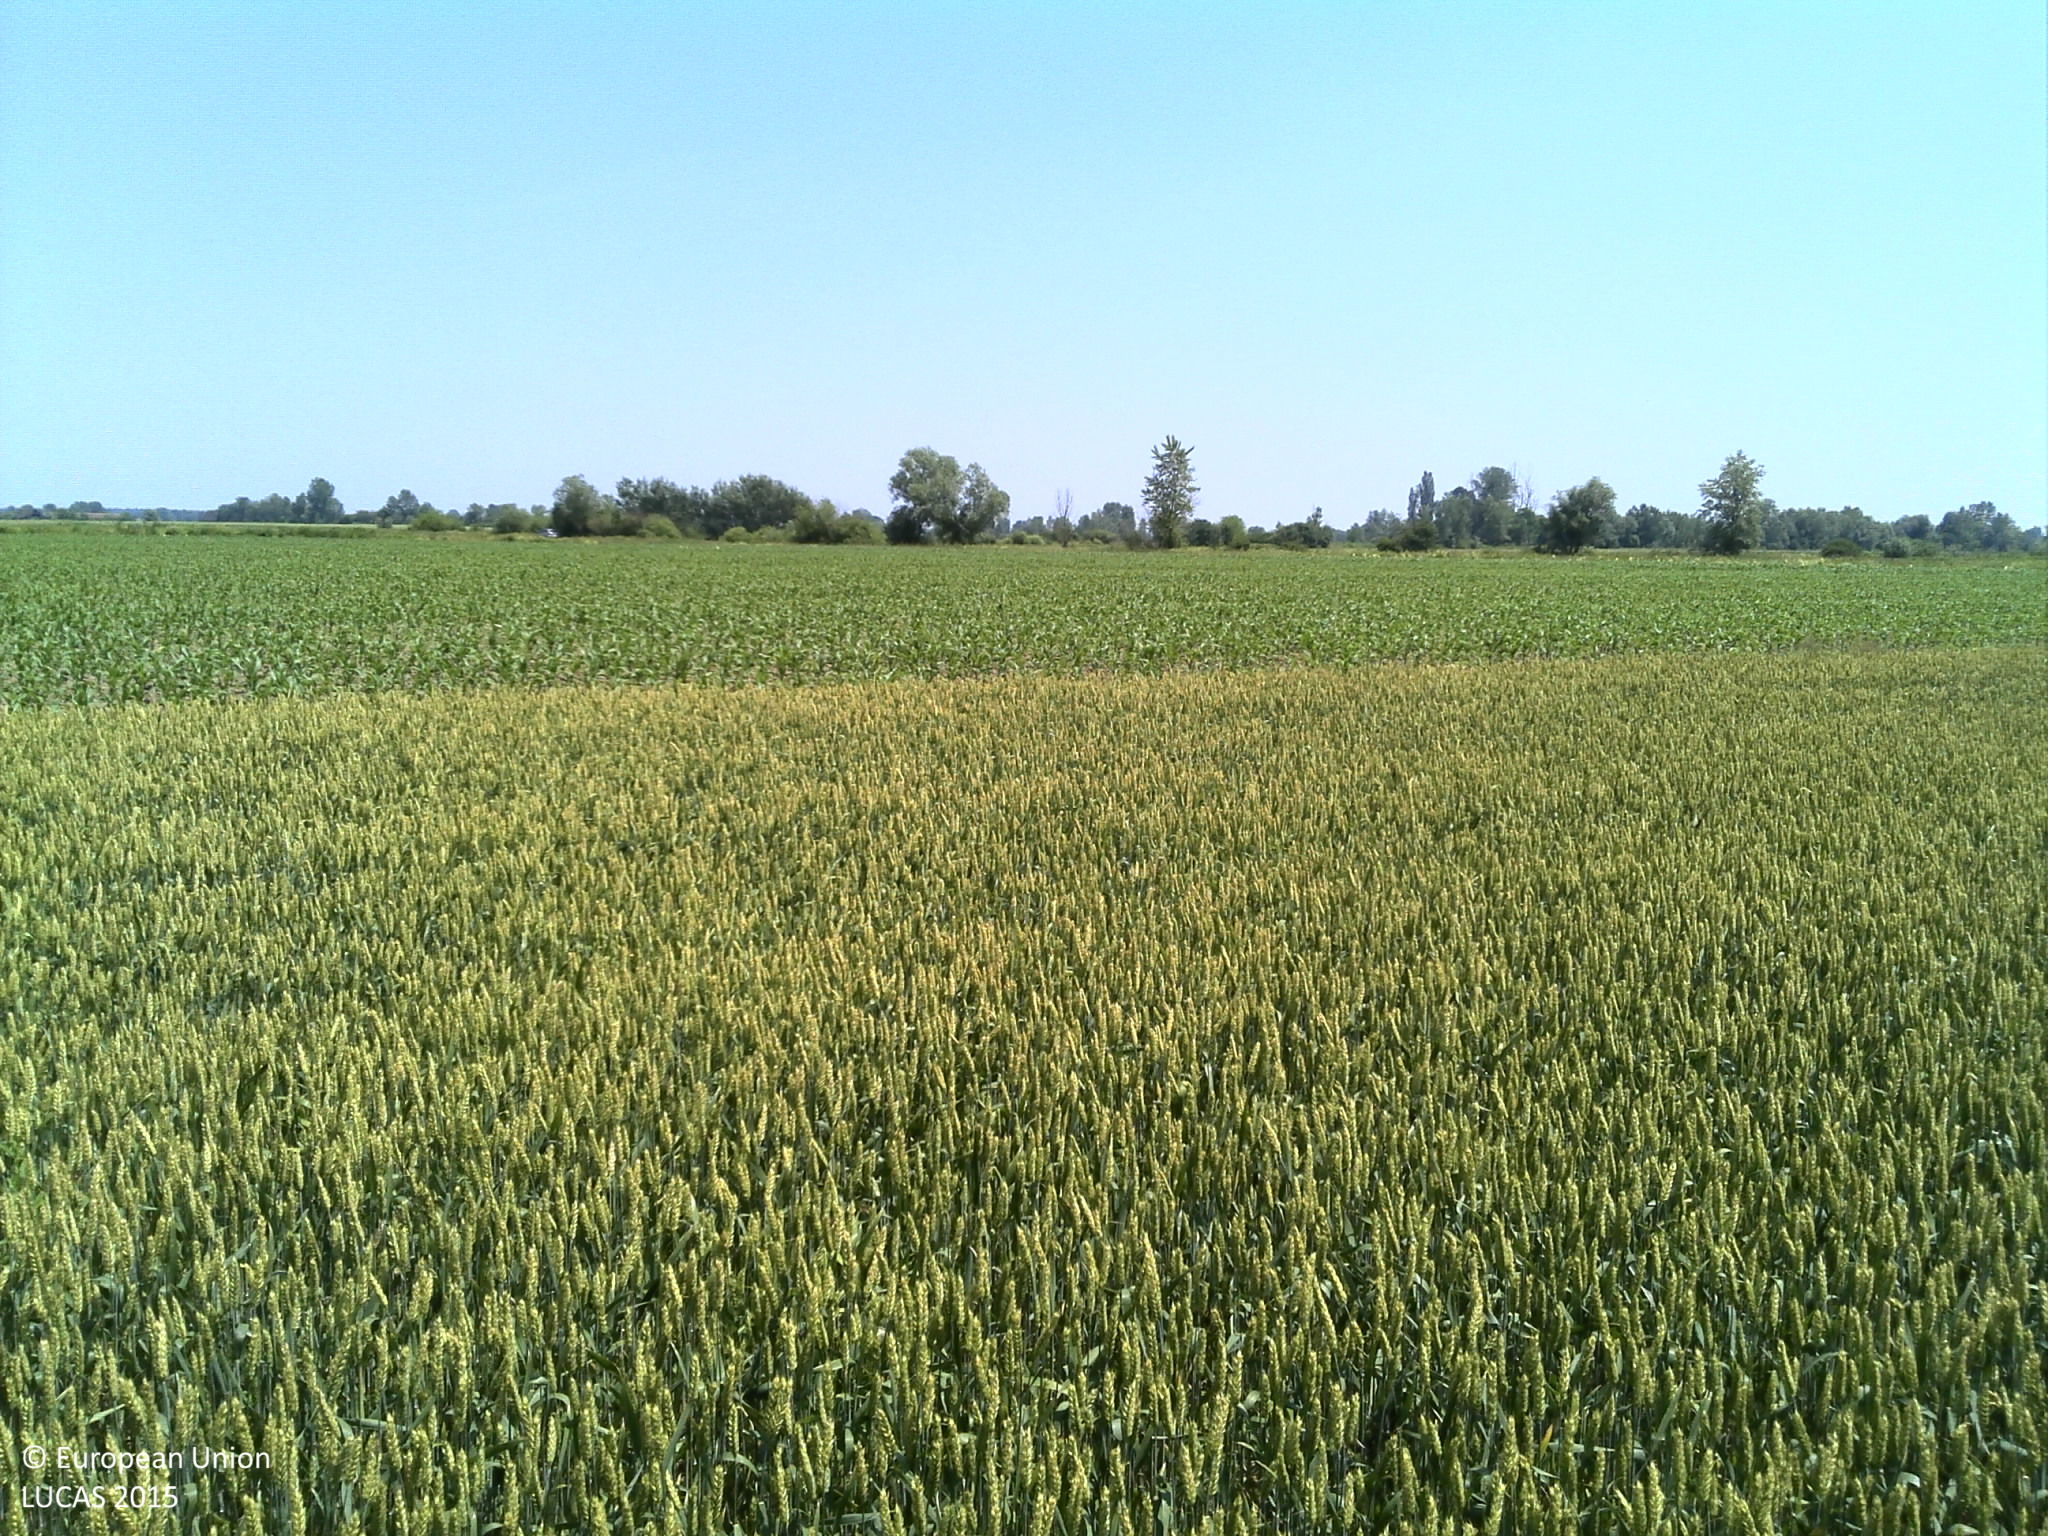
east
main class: Cropland
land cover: Common wheat
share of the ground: > 75 %
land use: Agriculture (excluding fallow land and kitchen gardens)
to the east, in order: Common wheat; Maize; Ditches and canals; Grass margins; Tracks; Grass margins; Ditches and canals; Single bushes/trees; Grass margins; Maize; Common wheat
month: June
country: HR
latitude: 44.9410
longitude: 18.9663
